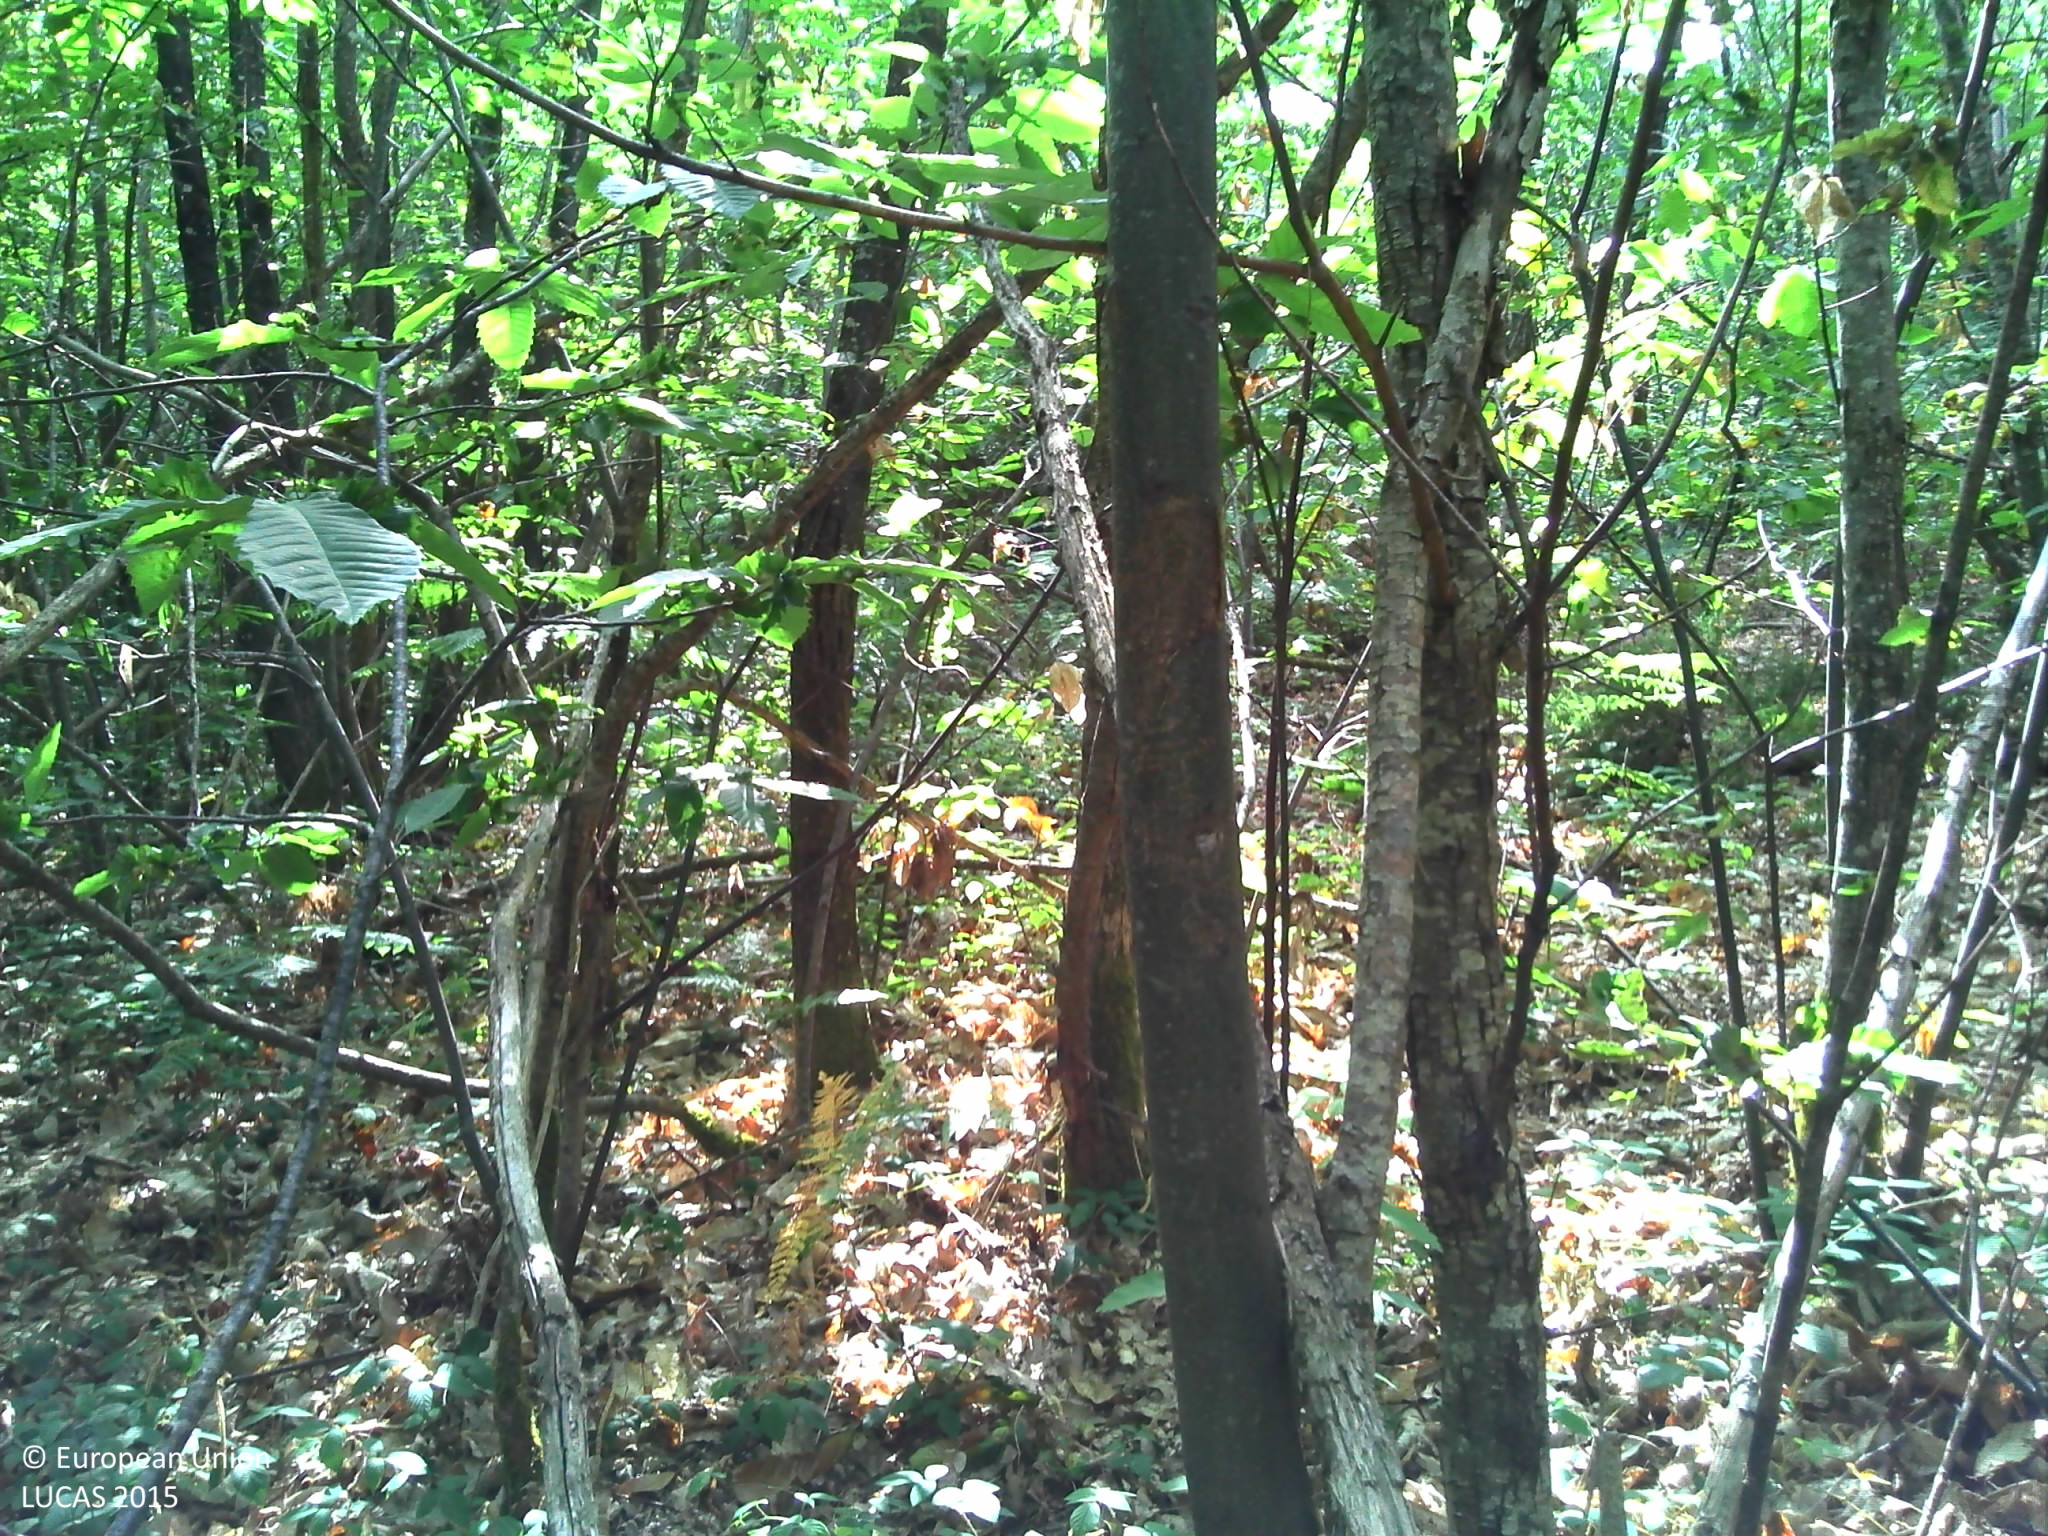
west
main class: Woodland
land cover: Broadleaved woodland
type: thermophilous deciduous forest
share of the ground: > 75 %
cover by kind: broadleaved forest trees 80 %, shrubs 10 %, herbaceous plants 10 %
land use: Forestry
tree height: > 5 m
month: July
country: FR
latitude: 45.0933
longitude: 0.7020
